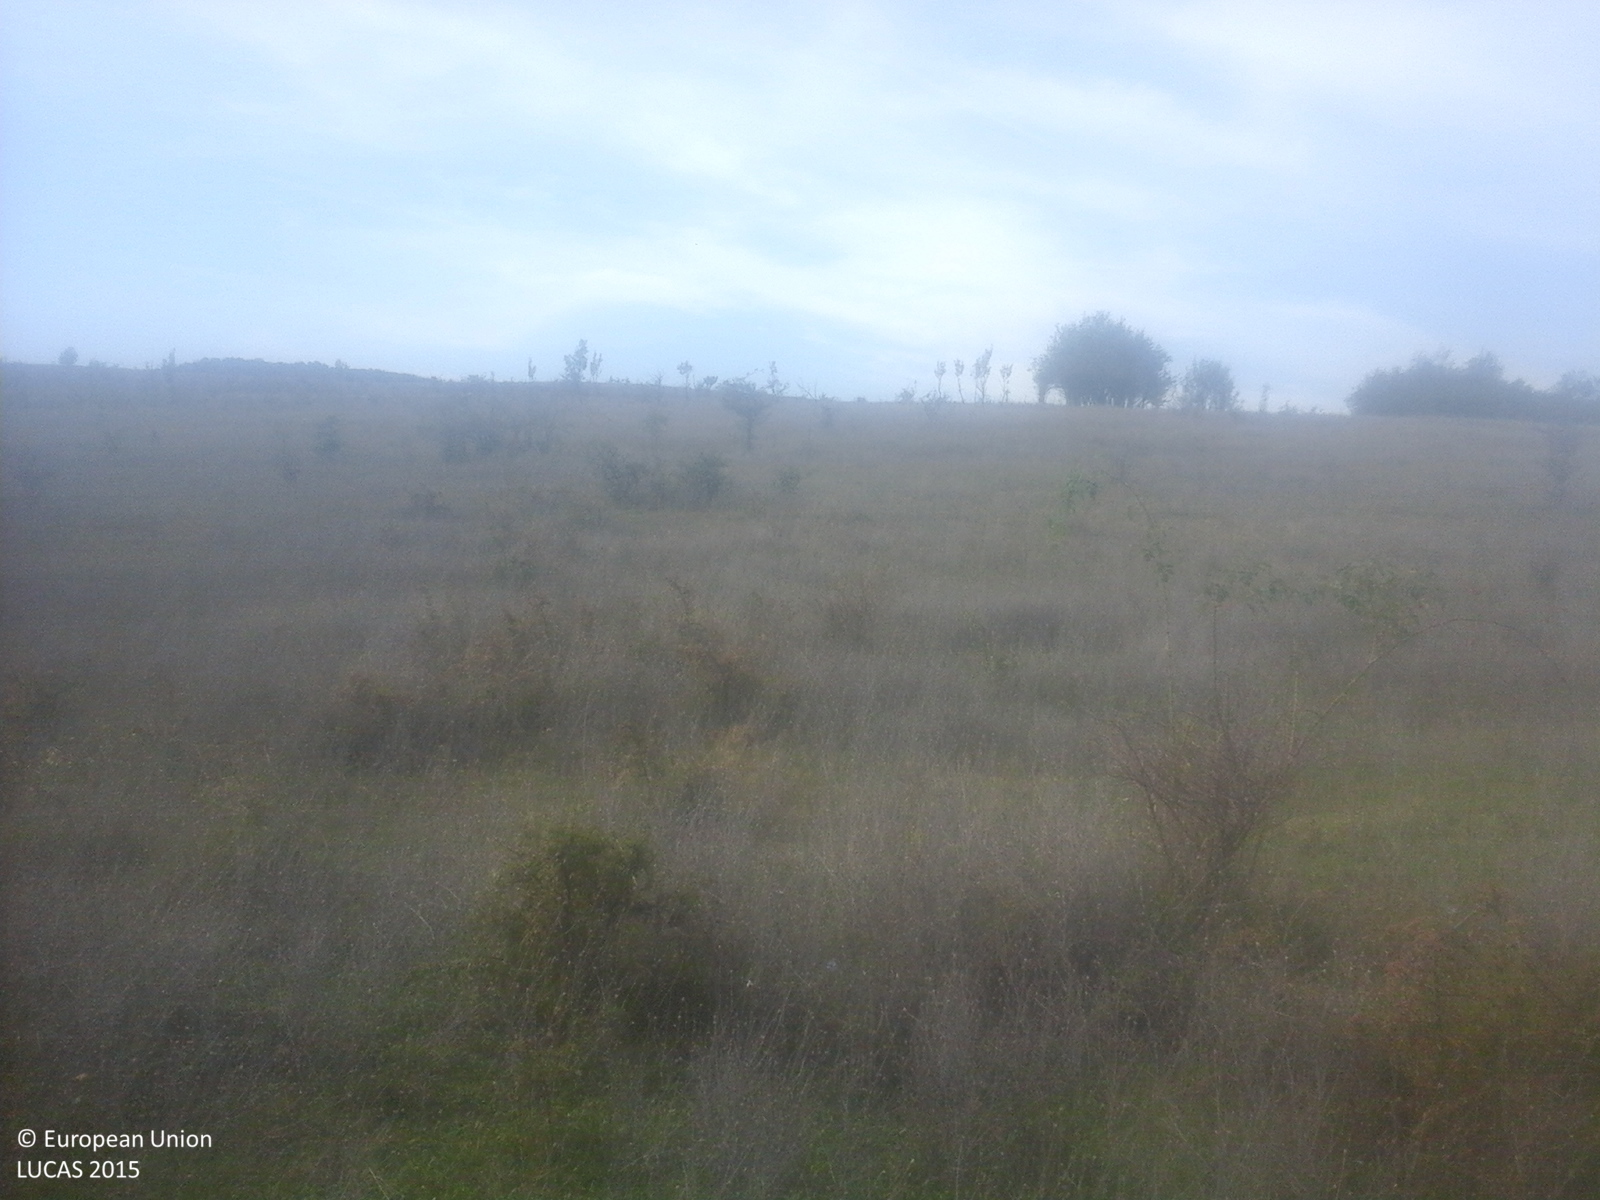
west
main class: Shrubland
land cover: Shrubland without tree cover
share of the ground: > 75 %
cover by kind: herbaceous plants 75 %, shrubs 25 %
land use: Agriculture (excluding fallow land and kitchen gardens)
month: September
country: RO
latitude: 47.0000
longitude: 23.6856
